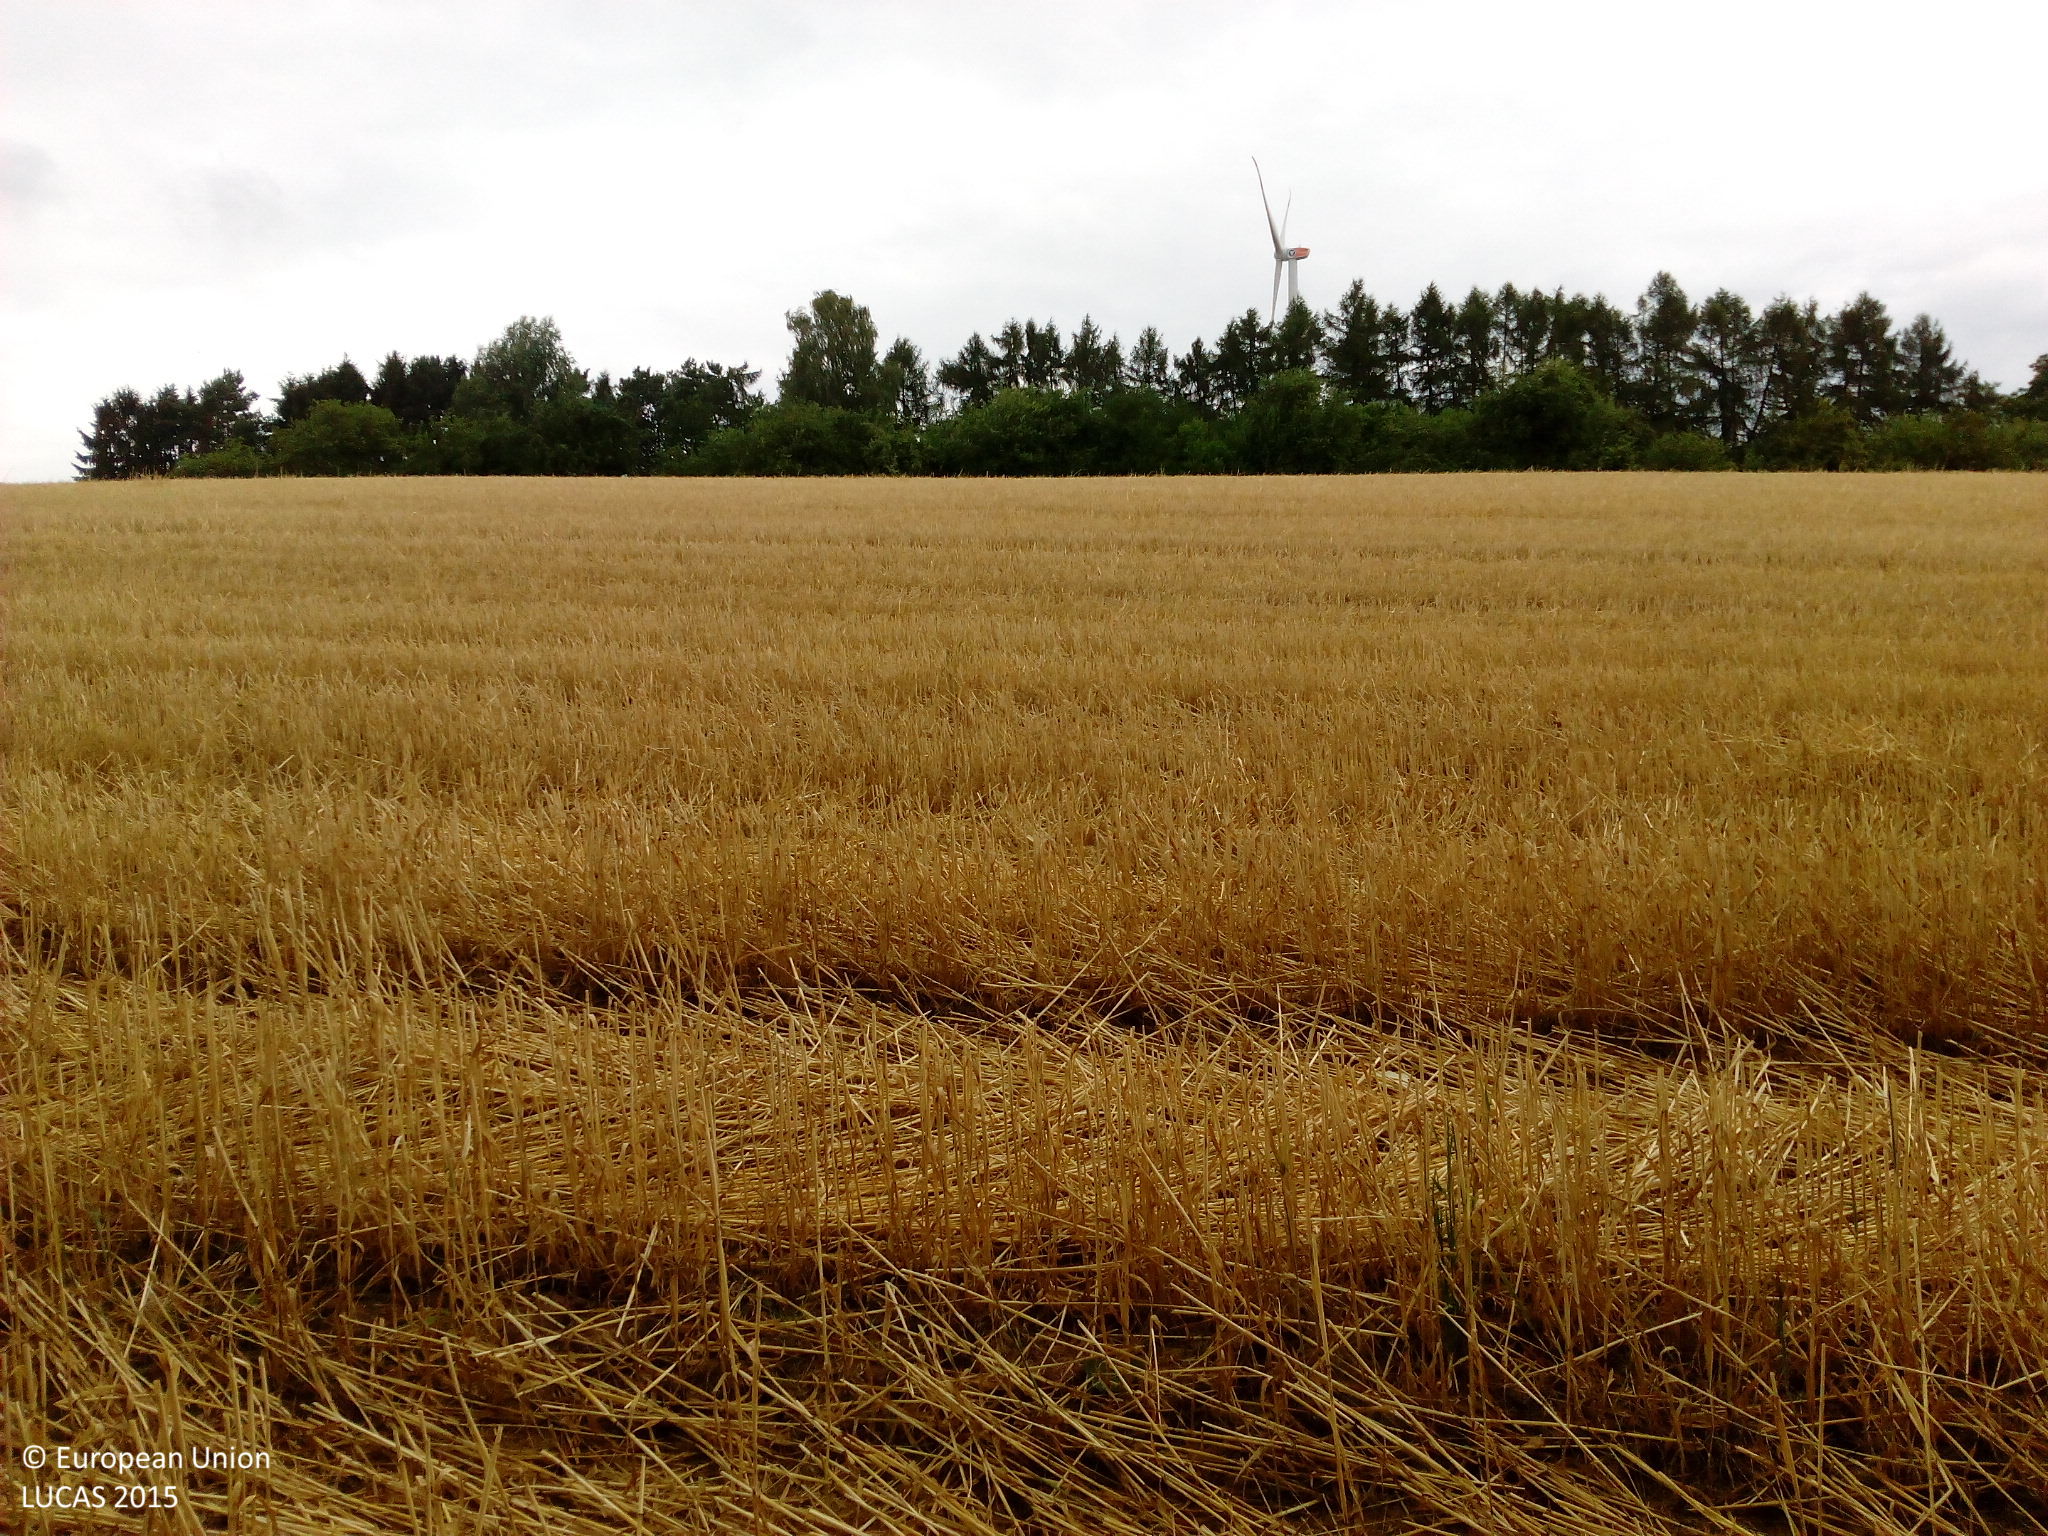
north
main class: Cropland
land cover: Barley
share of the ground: > 75 %
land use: Agriculture (excluding fallow land and kitchen gardens)
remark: Harvested field
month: July
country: DE
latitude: 49.3748
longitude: 7.1494
